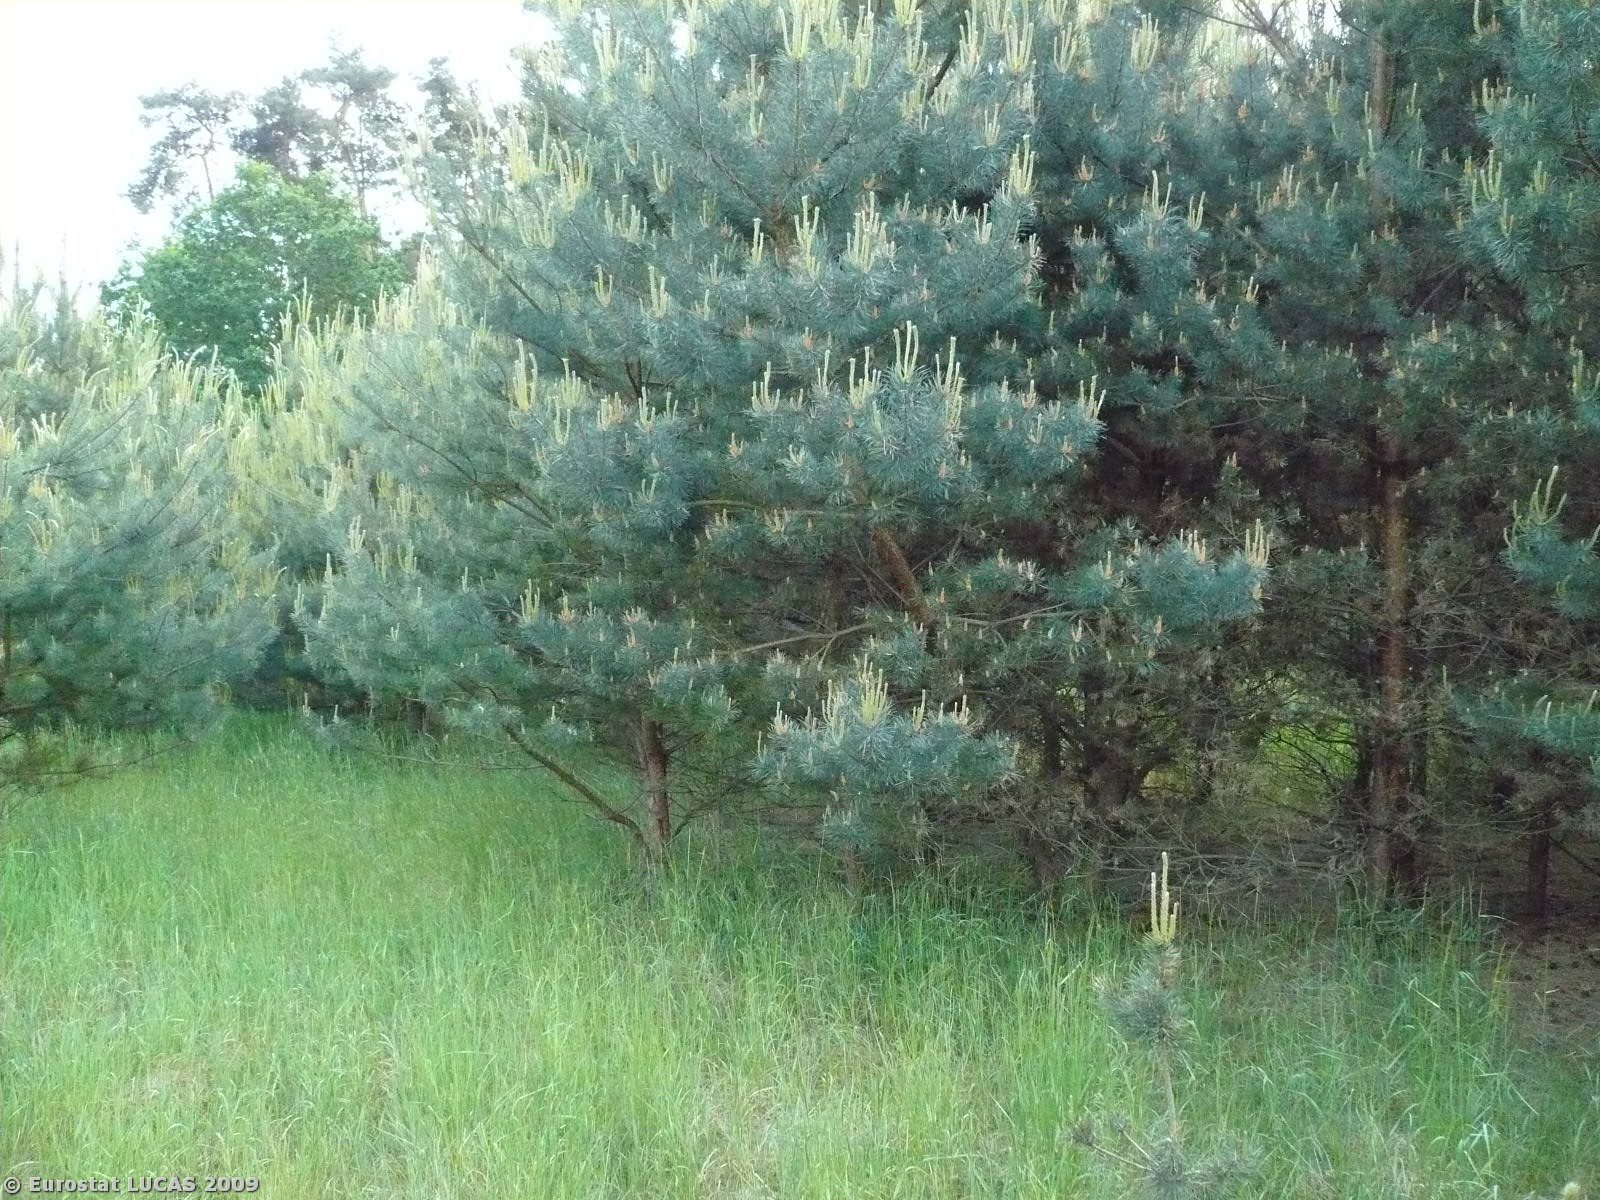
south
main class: Woodland
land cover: Coniferous woodland
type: hemiboreal forest and nemoral coniferous forest and mixed broadleaved-coniferous forest
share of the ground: 50 - 75 %
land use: Forestry
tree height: > 5 m
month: May
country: PL
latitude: 52.0764
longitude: 15.3585
